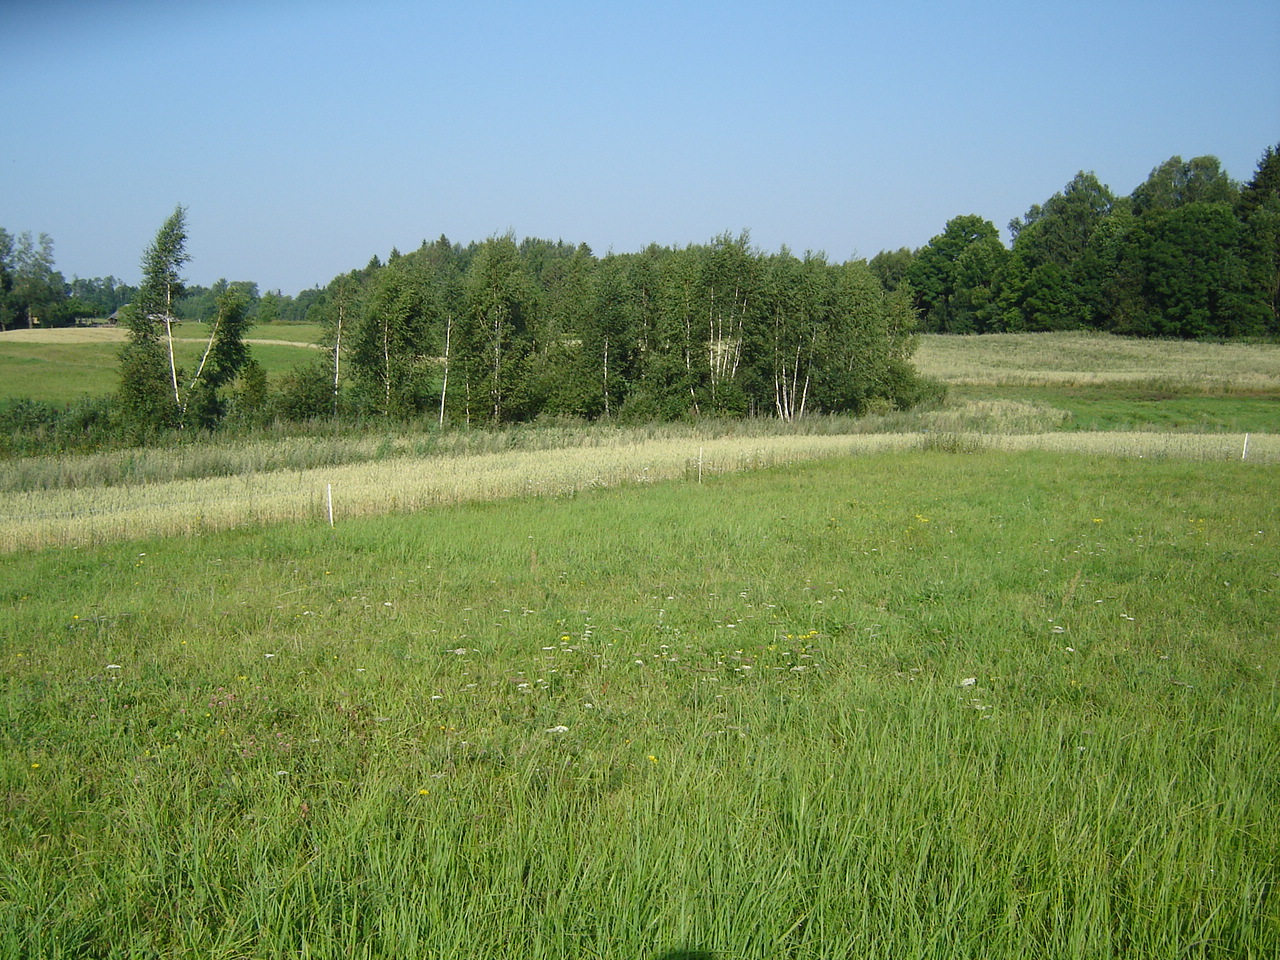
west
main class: Grassland
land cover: Grassland without tree/shrub cover
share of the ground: > 75 %
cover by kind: herbaceous plants 100 %
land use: Agriculture (excluding fallow land and kitchen gardens)
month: August
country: LT
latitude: 55.1891
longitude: 25.1482
